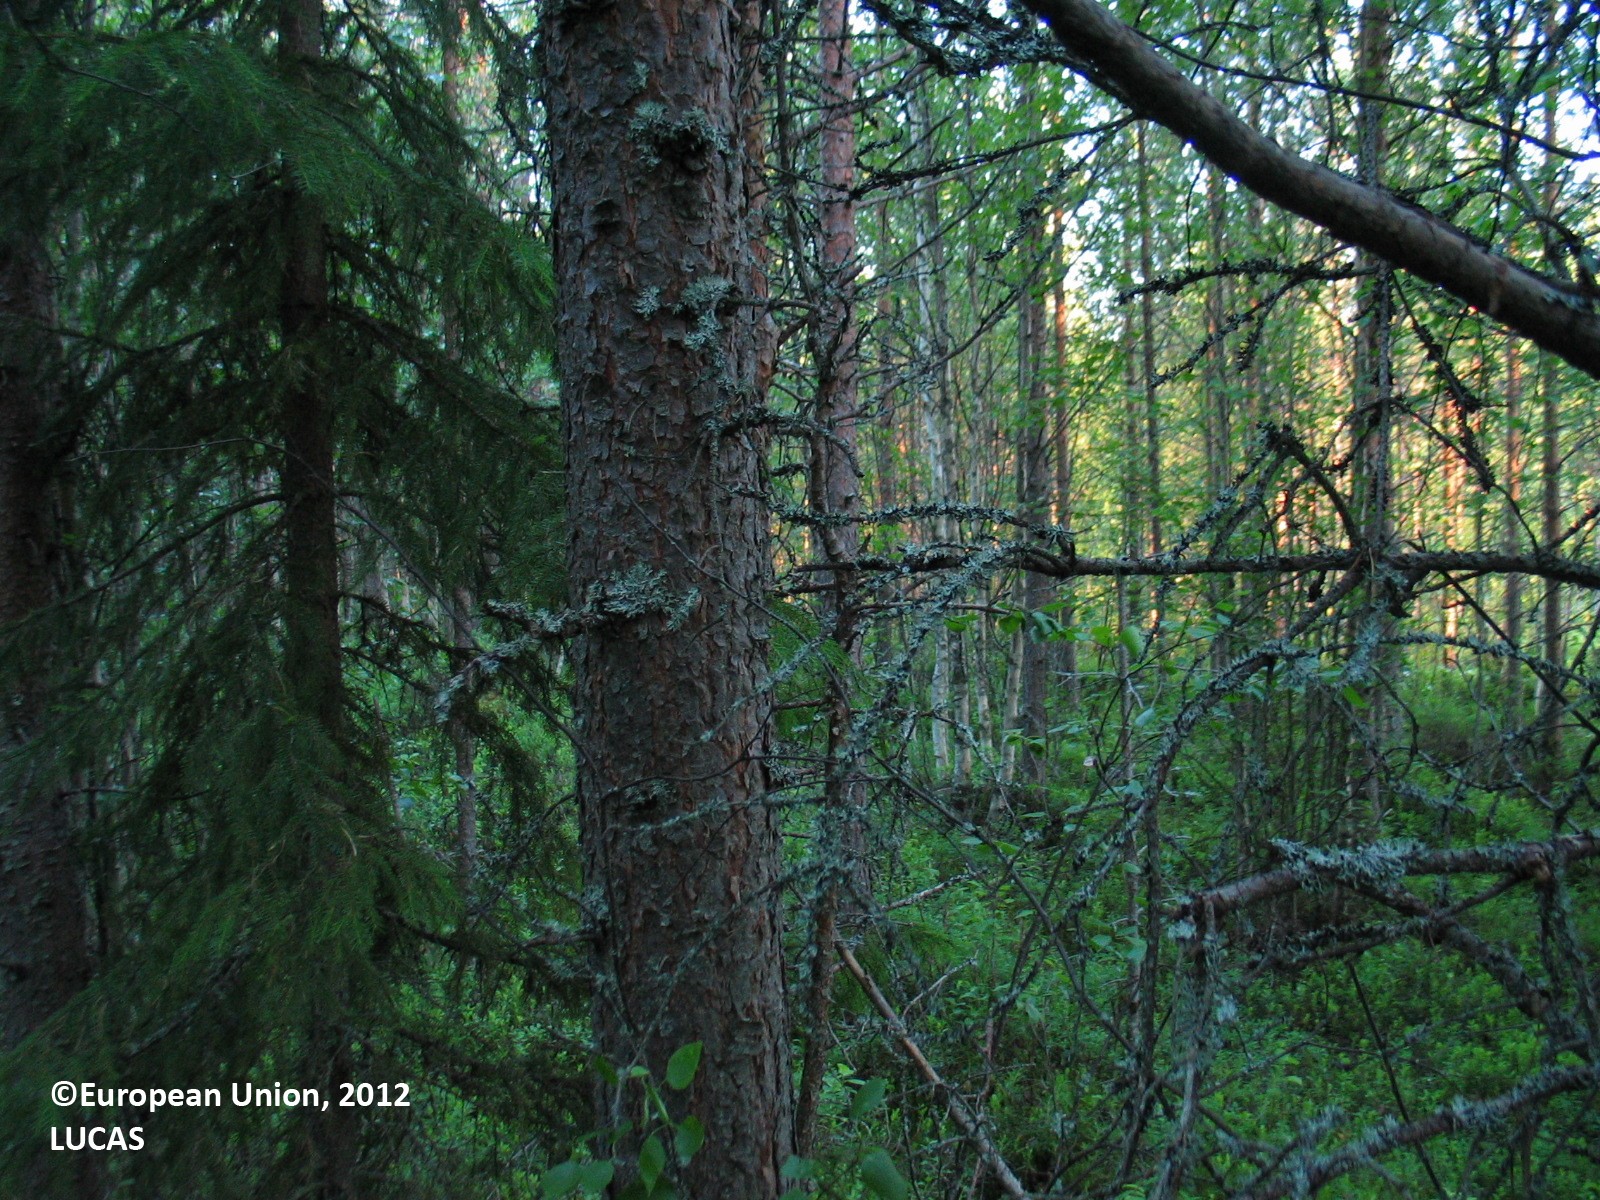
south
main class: Woodland
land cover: Pine dominated mixed woodland
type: boreal forest
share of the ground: > 75 %
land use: Forestry
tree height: > 5 m
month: July
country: FI
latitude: 64.7912
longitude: 26.6328
